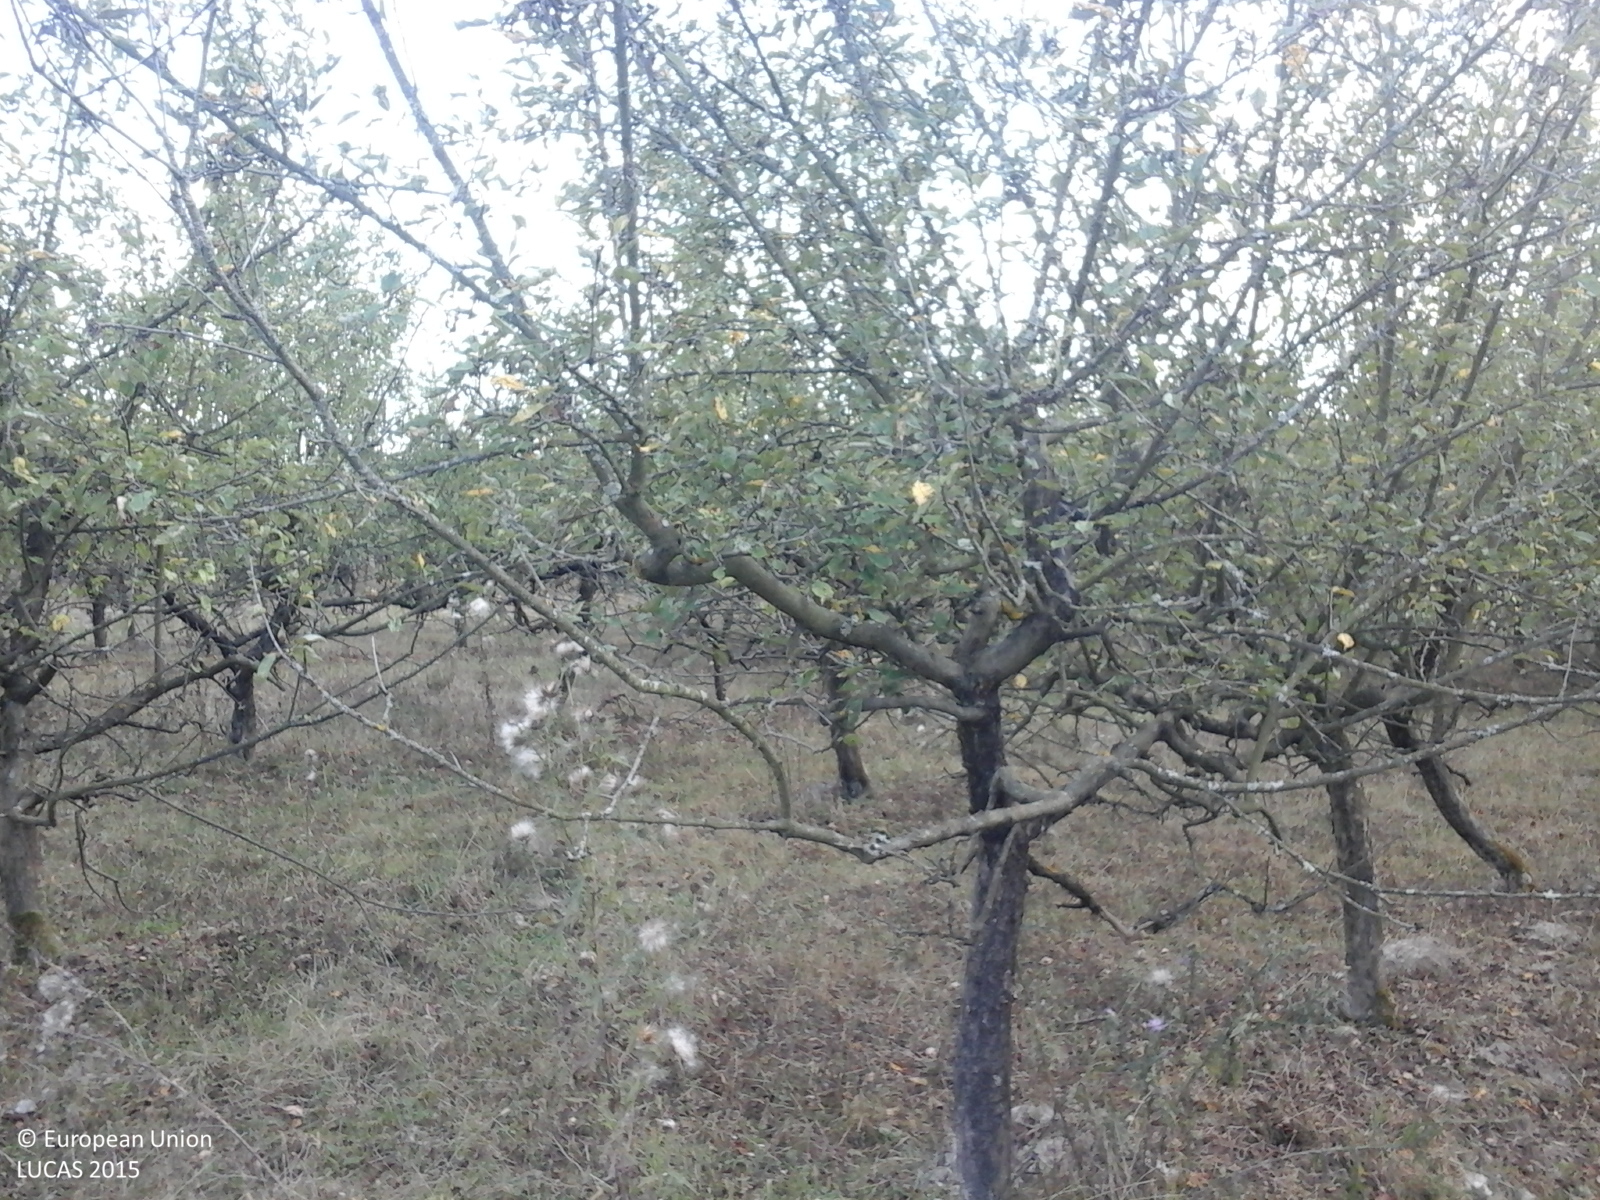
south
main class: Cropland
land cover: Apple fruit
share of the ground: > 75 %
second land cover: Grassland without tree/shrub cover
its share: > 75 %
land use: Agriculture (excluding fallow land and kitchen gardens)
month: September
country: RO
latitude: 47.5228
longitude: 23.4469
